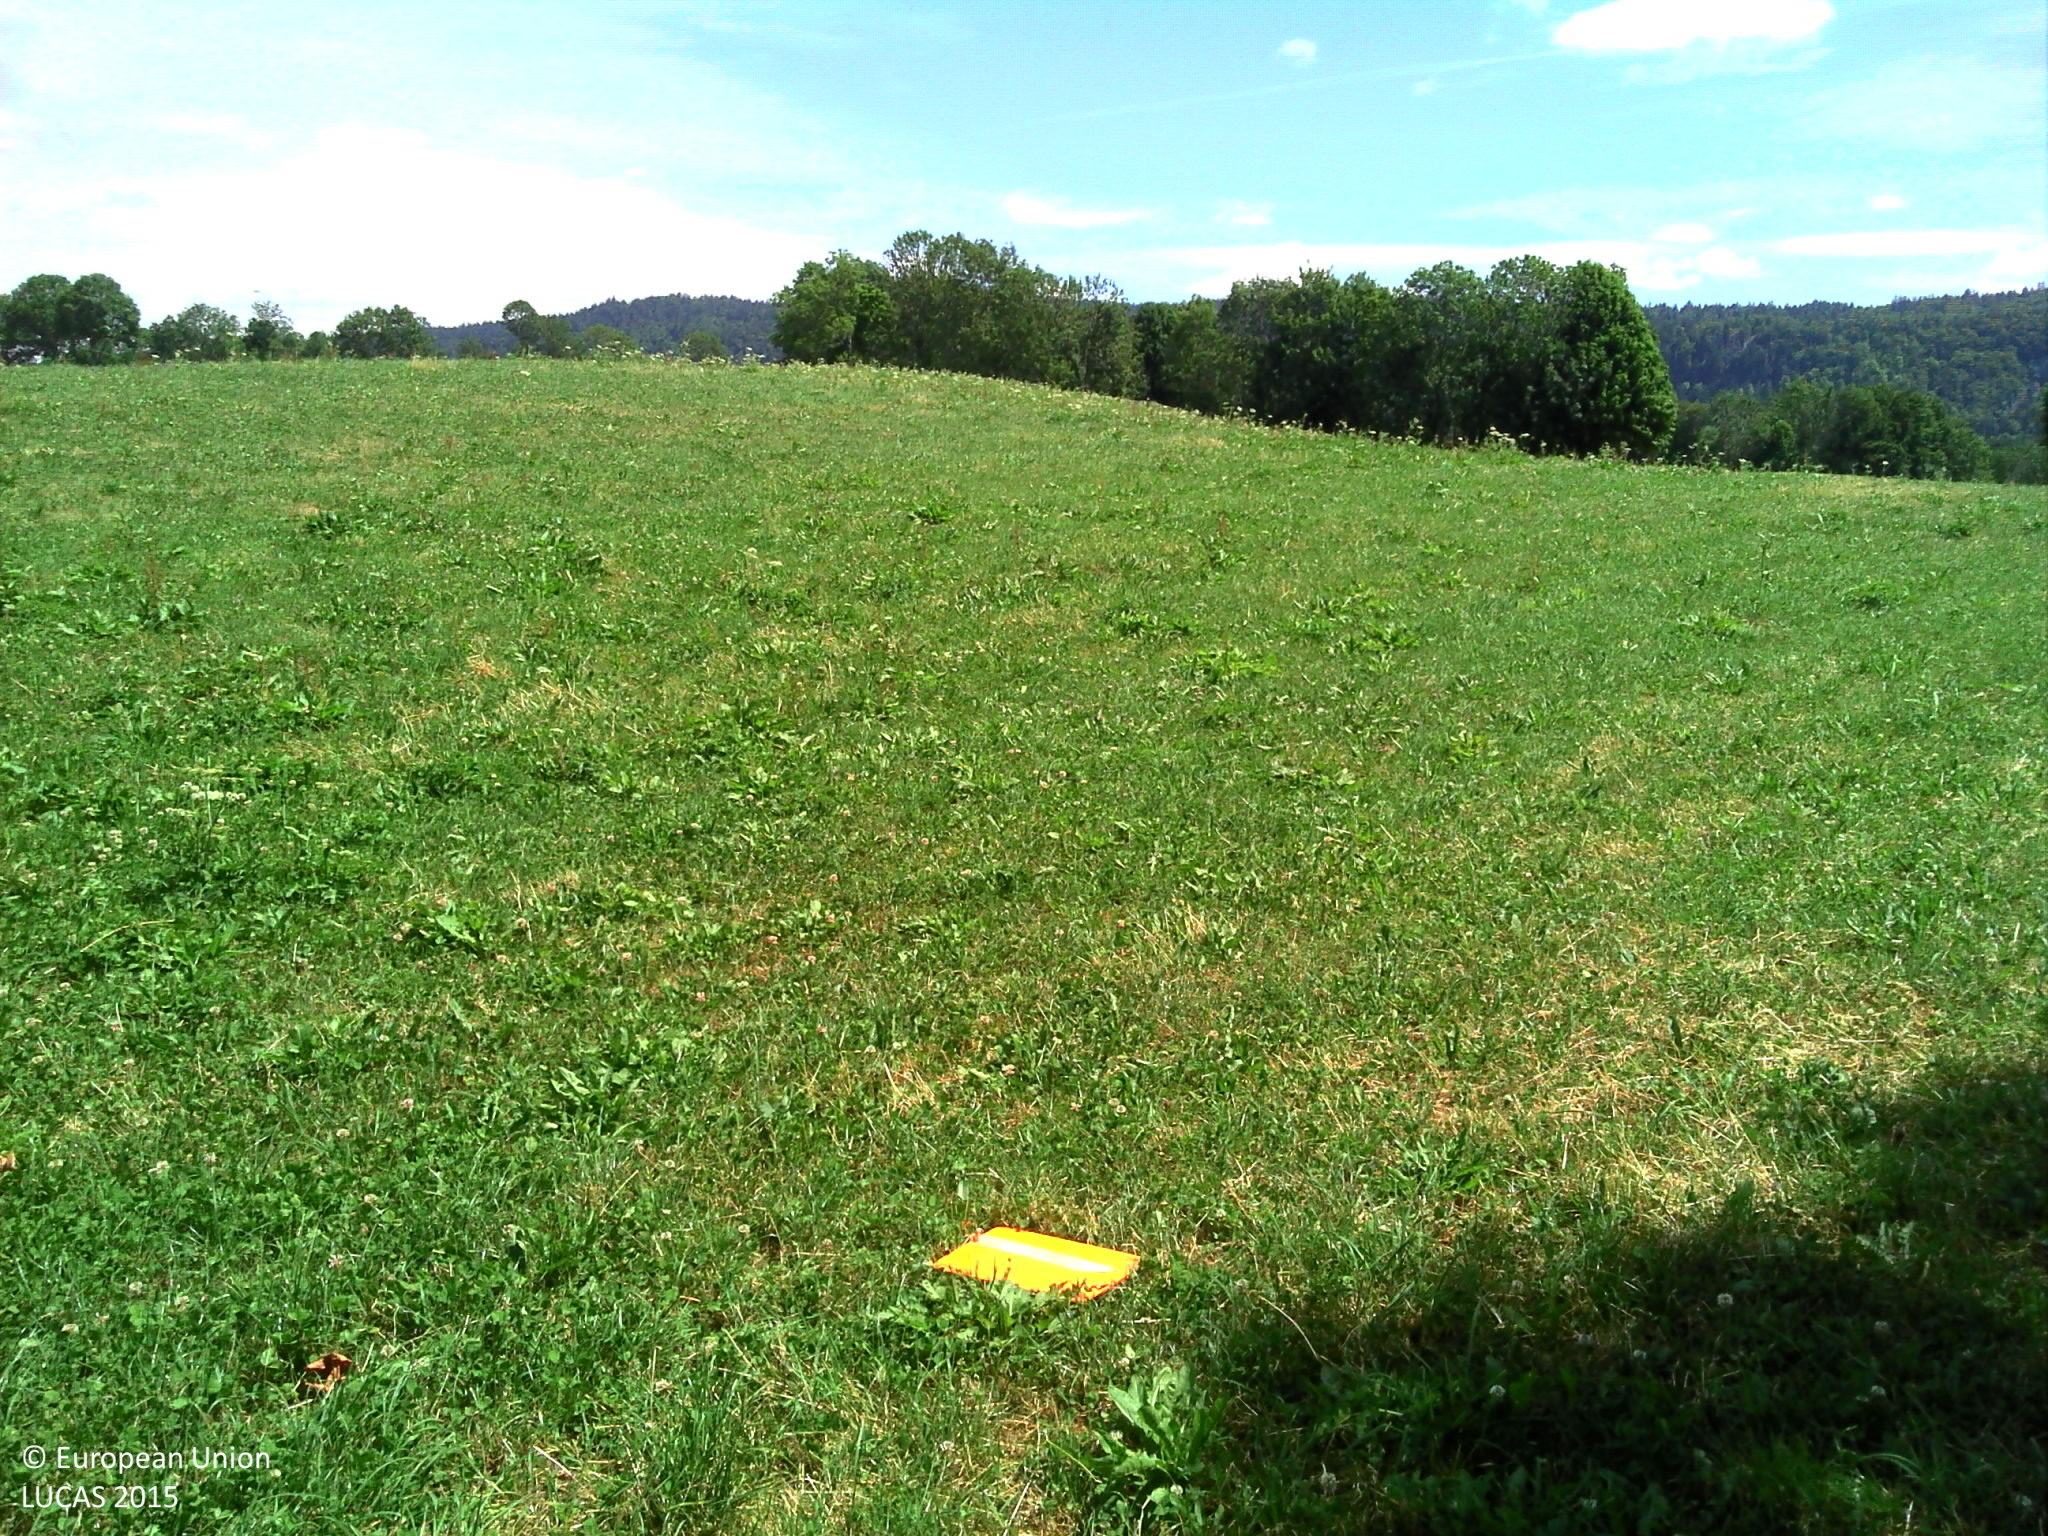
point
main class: Grassland
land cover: Grassland without tree/shrub cover
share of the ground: > 75 %
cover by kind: herbaceous plants 100 %
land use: Agriculture (excluding fallow land and kitchen gardens)
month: July
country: FR
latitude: 46.7305
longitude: 6.0900
